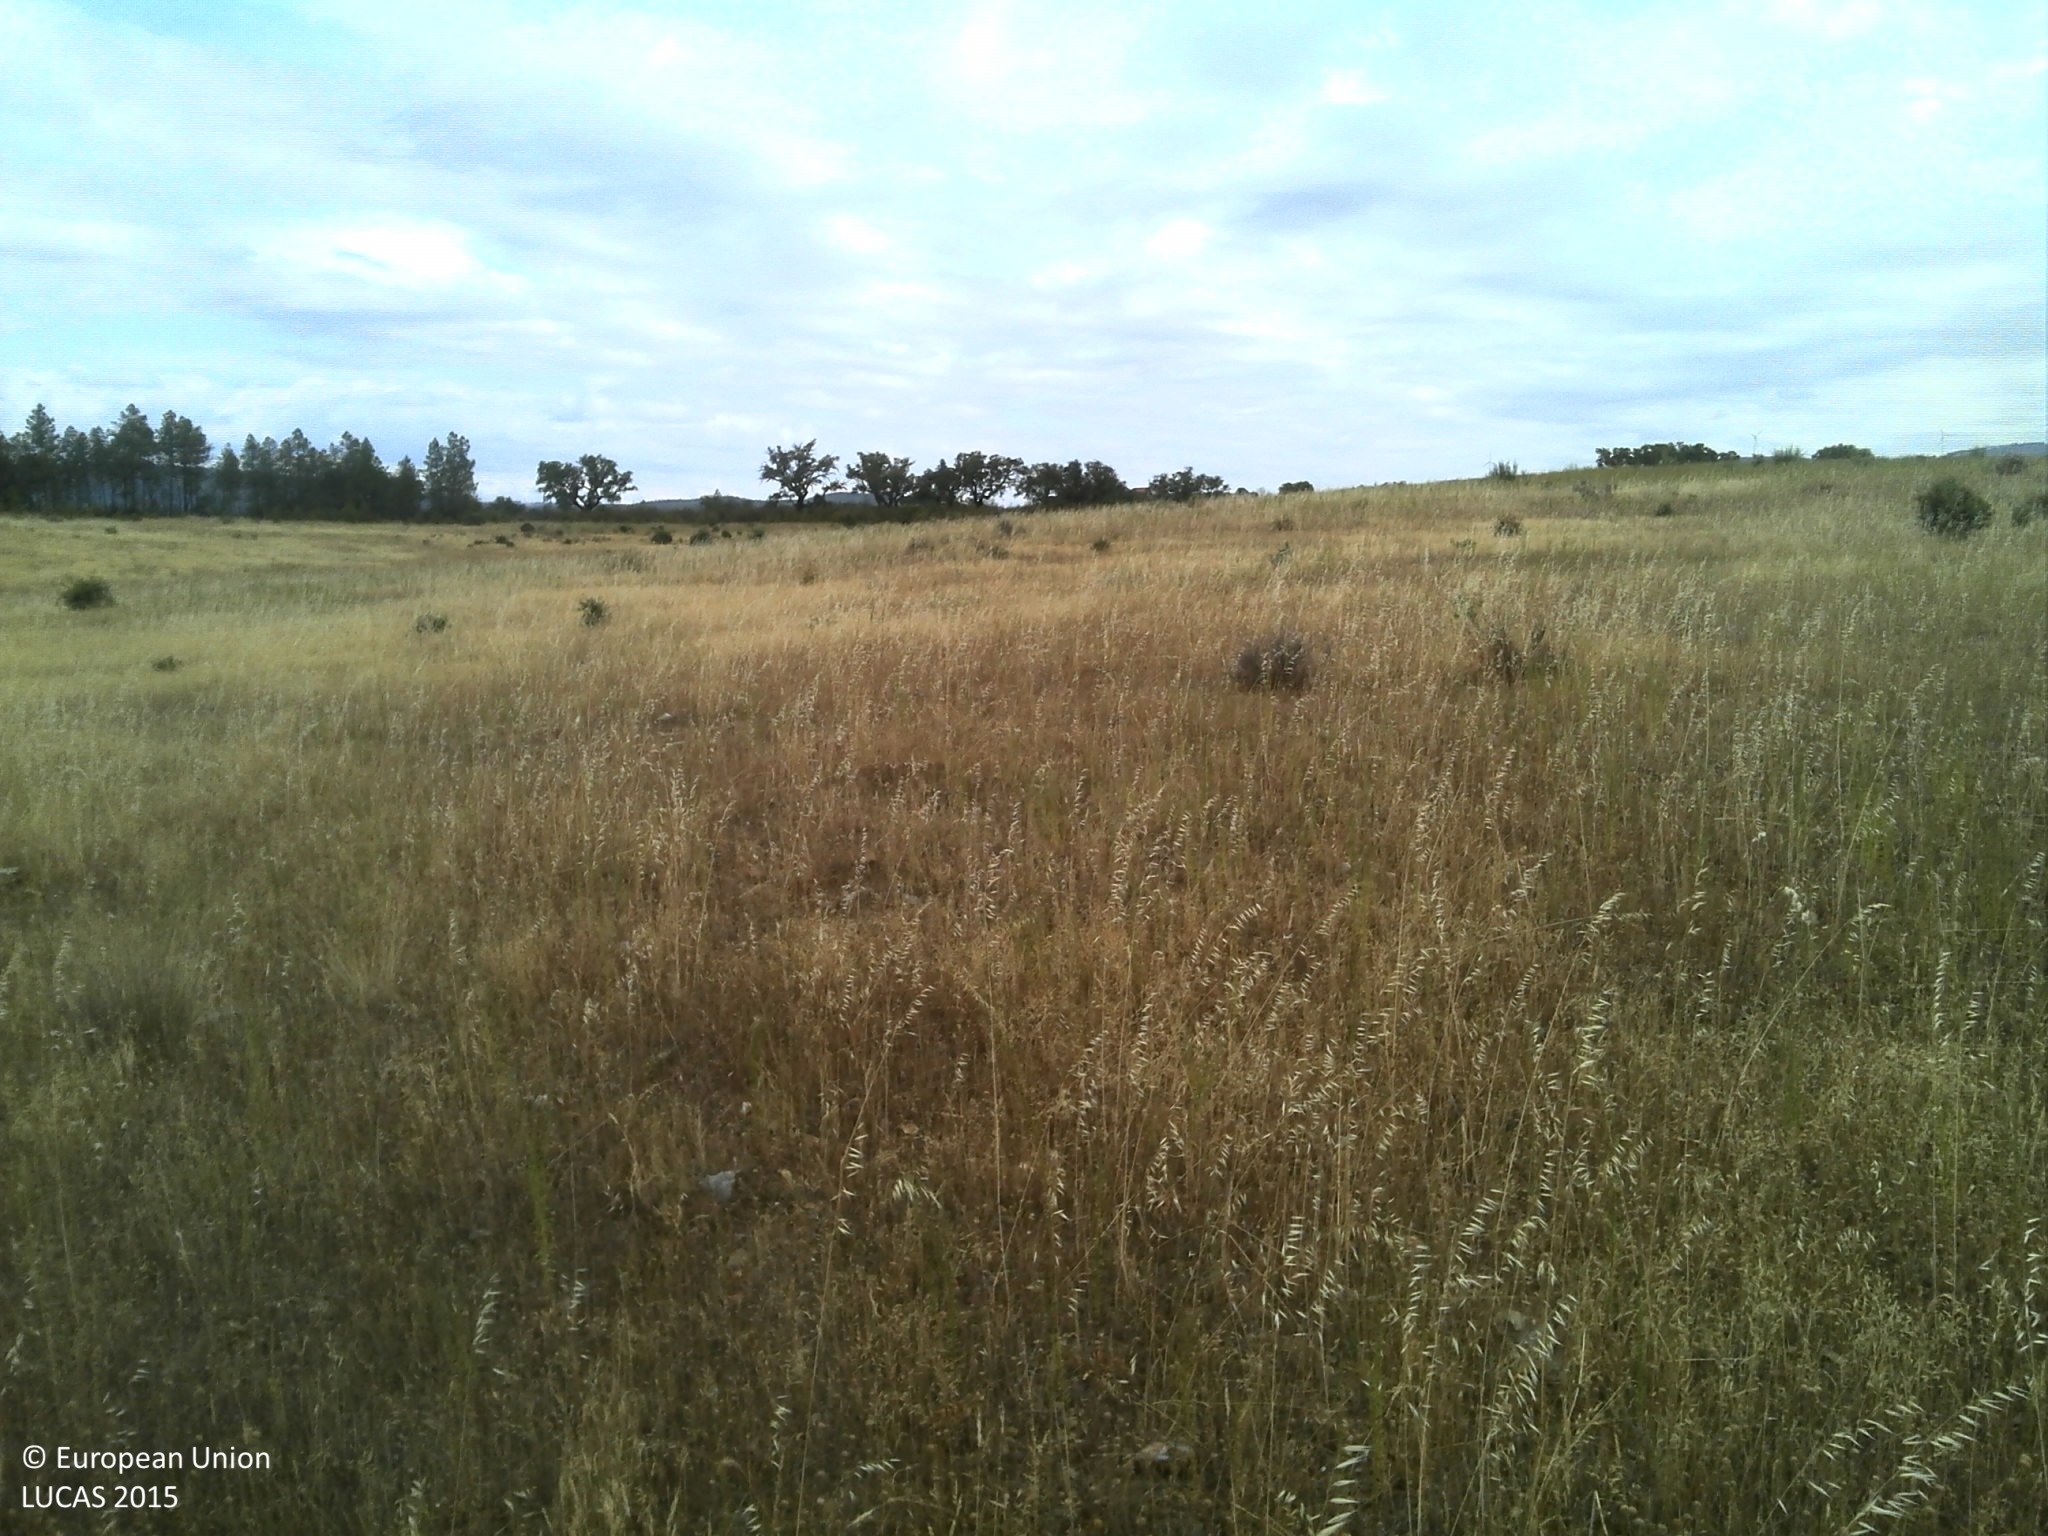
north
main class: Grassland
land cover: Grassland without tree/shrub cover
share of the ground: 50 - 75 %
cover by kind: herbaceous plants 60 %, unconsolidated bare surface 35 %, shrubs 5 %
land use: Agriculture (excluding fallow land and kitchen gardens)
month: June
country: PT
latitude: 40.1430
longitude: -7.2717
